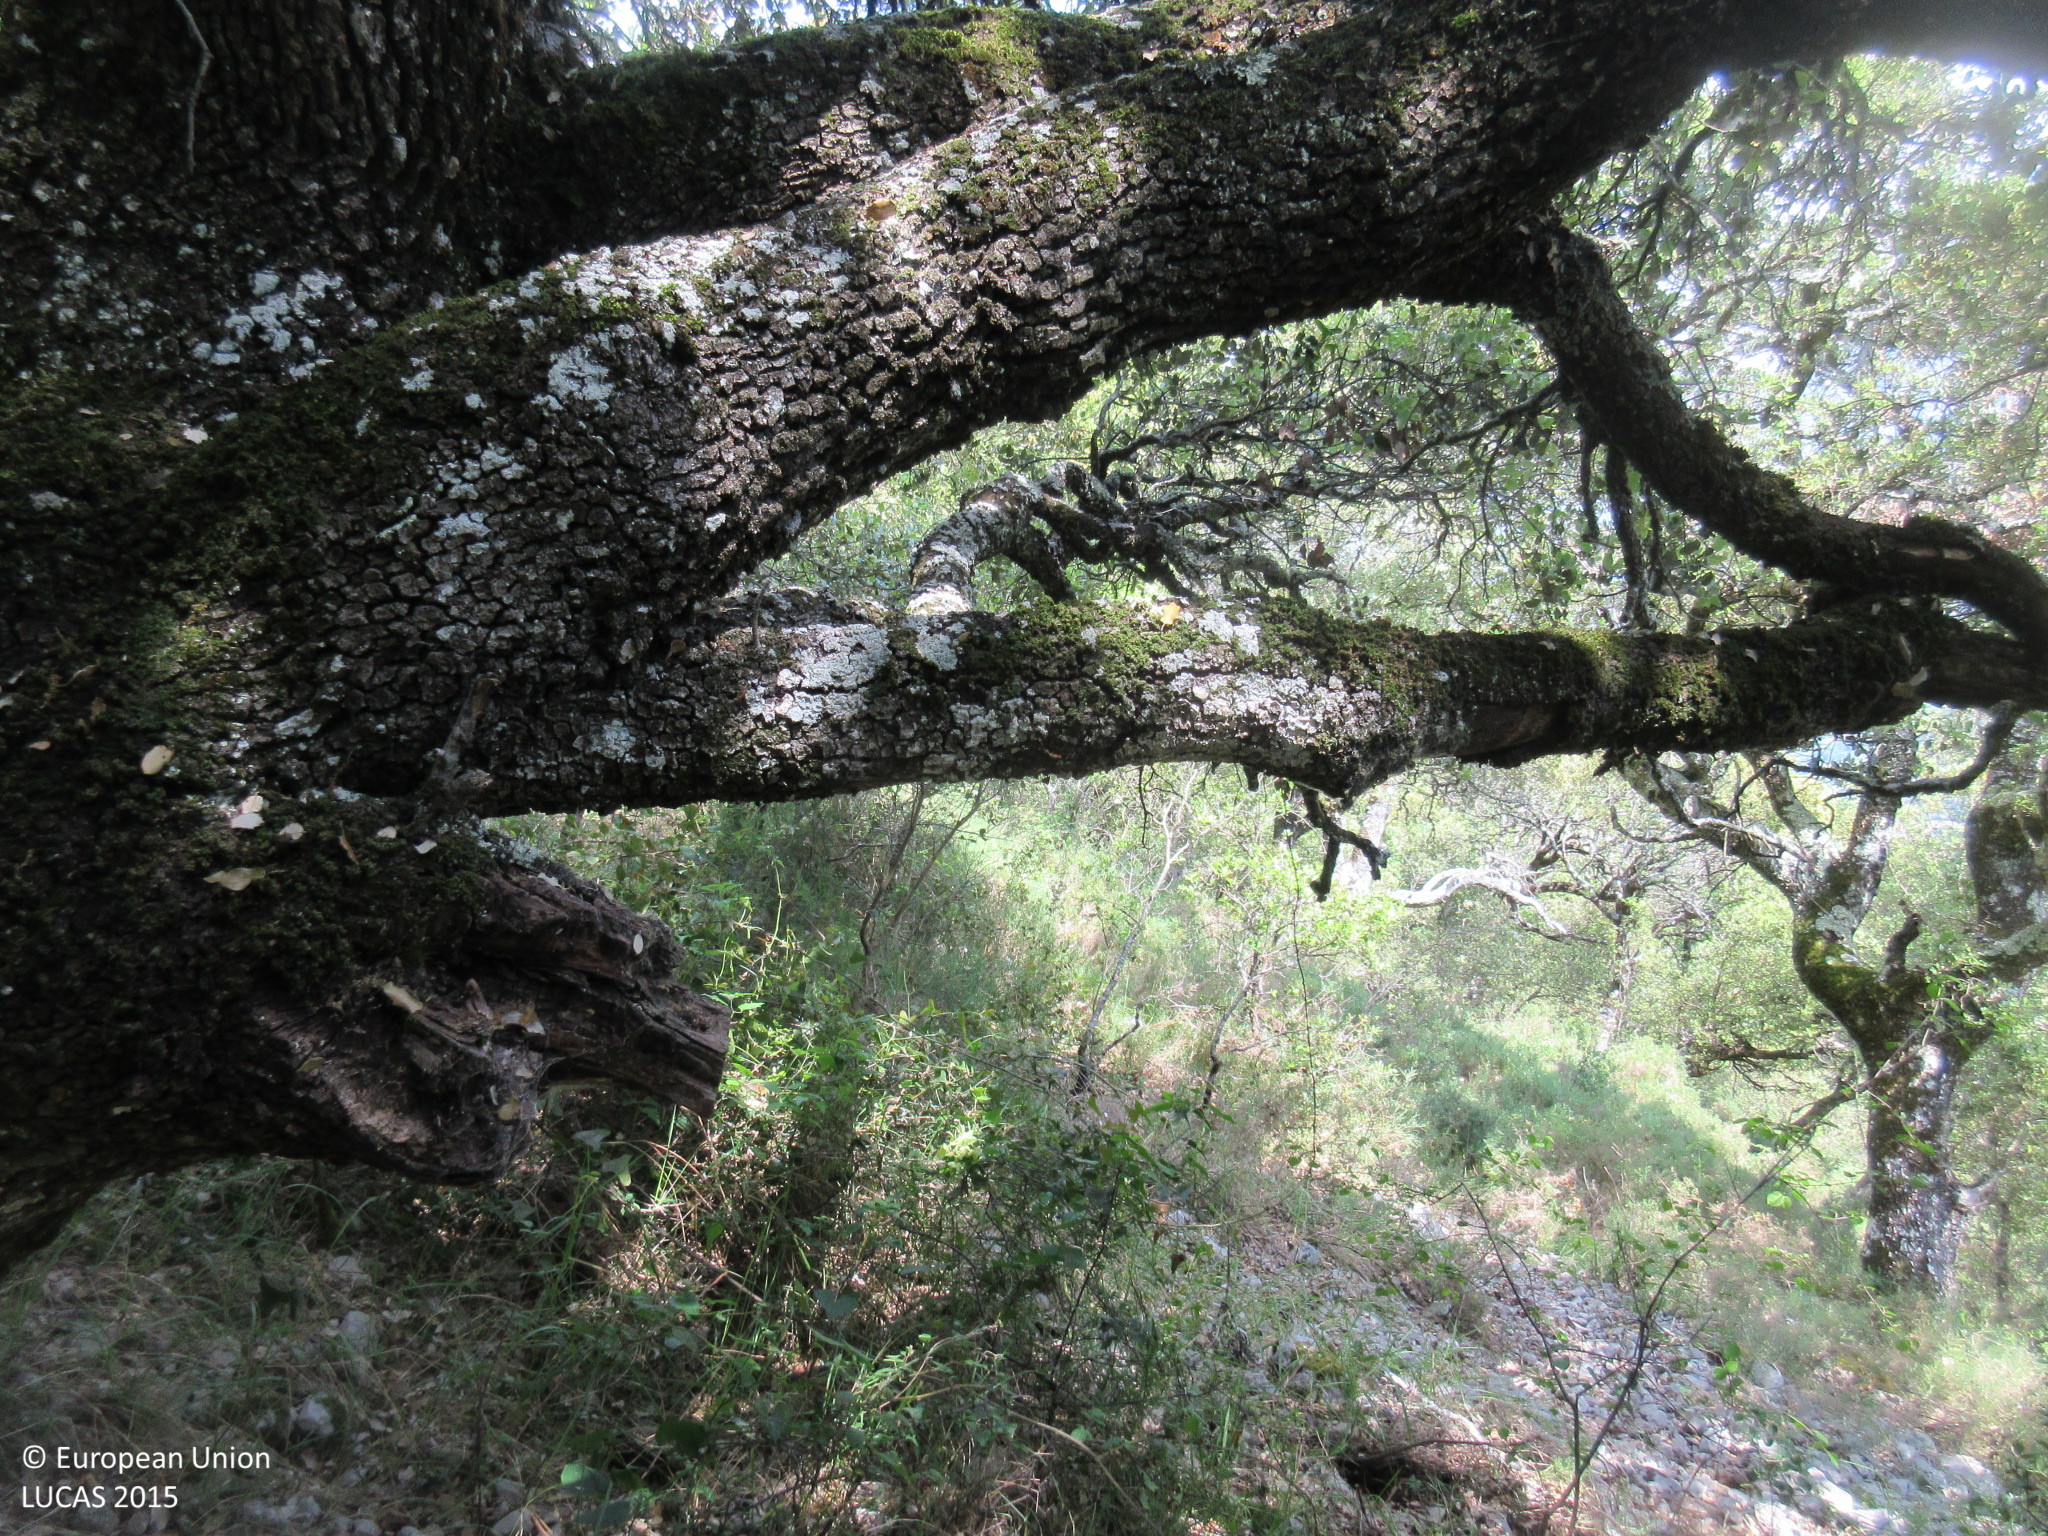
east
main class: Woodland
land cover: Broadleaved woodland
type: broadleaved evergreen forest
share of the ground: > 75 %
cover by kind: broadleaved forest trees 90 %, shrubs 10 %
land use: Agriculture (excluding fallow land and kitchen gardens)
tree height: > 5 m
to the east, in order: Broadleaved woodland
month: May
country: ES
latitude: 43.2199
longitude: -4.5996
